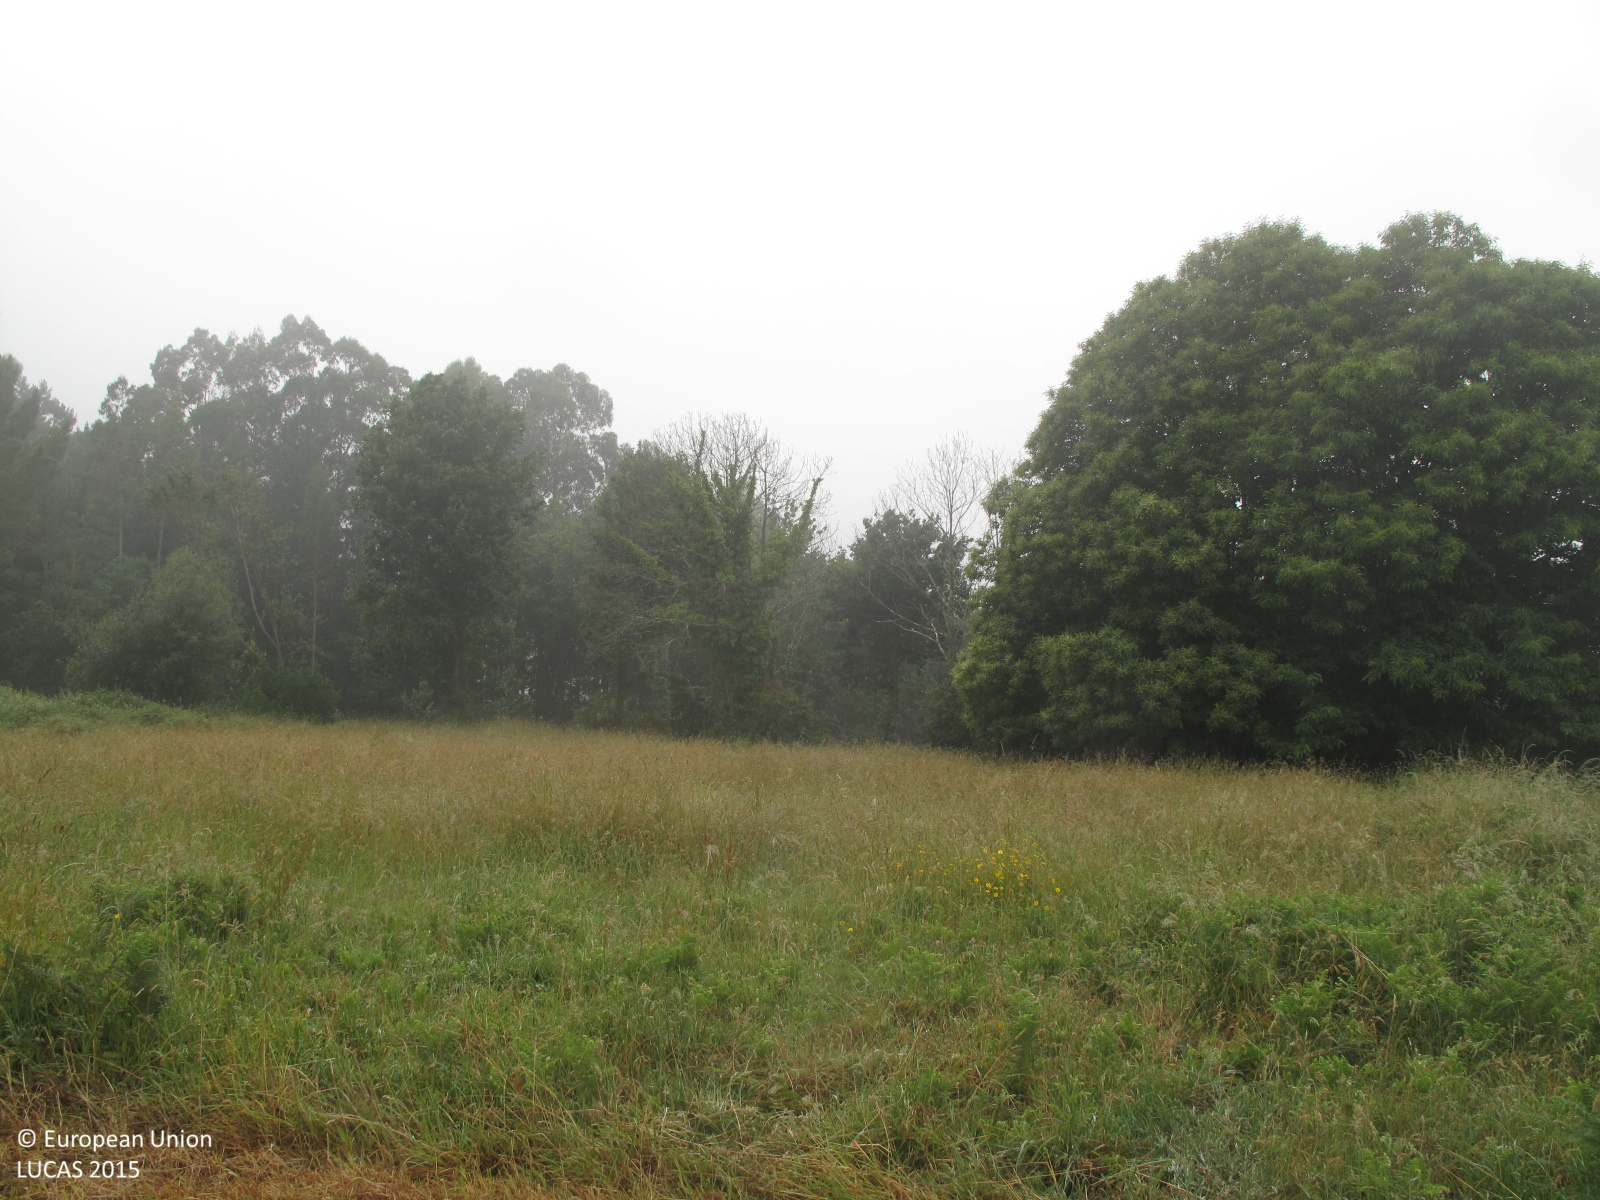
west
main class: Grassland
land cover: Grassland without tree/shrub cover
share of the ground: > 75 %
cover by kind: herbaceous plants 80 %, unconsolidated bare surface 20 %
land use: Agriculture (excluding fallow land and kitchen gardens)
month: June
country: ES
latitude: 43.1775
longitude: -8.2452
